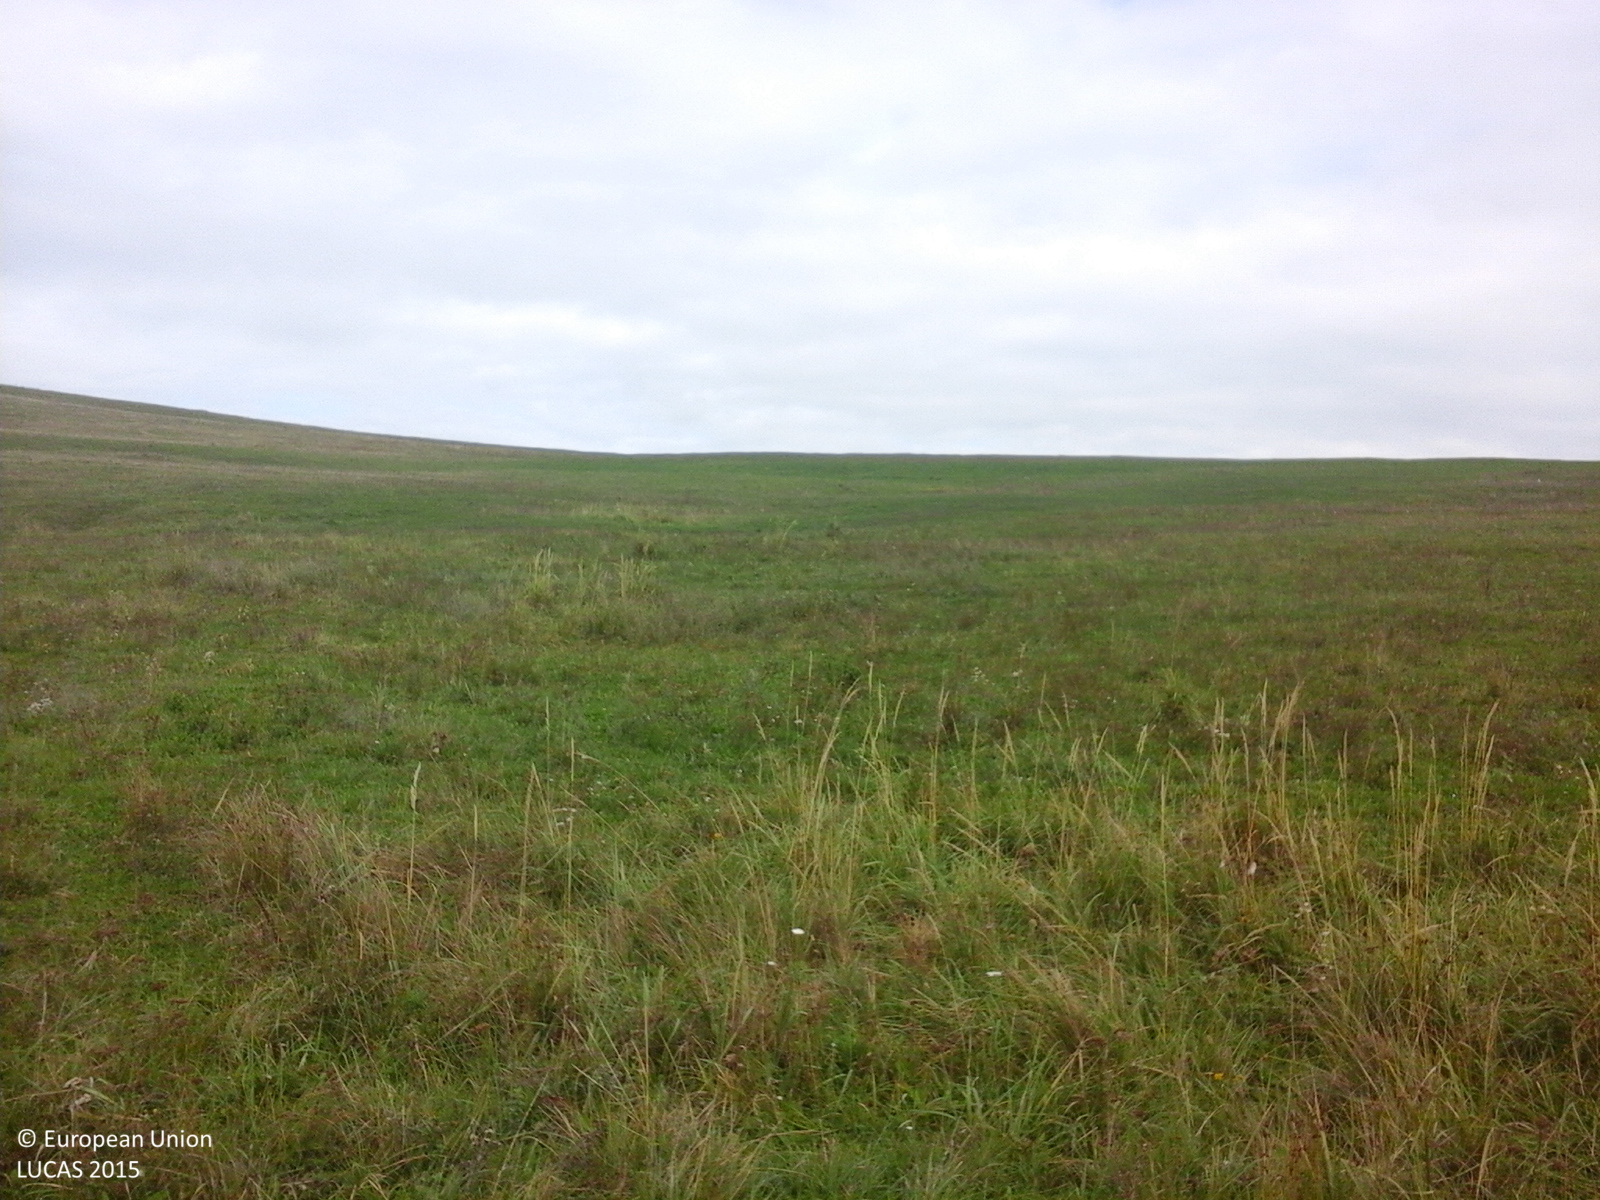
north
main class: Grassland
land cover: Grassland without tree/shrub cover
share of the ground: > 75 %
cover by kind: herbaceous plants 100 %
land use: Agriculture (excluding fallow land and kitchen gardens)
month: October
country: RO
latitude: 46.6581
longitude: 24.8759
